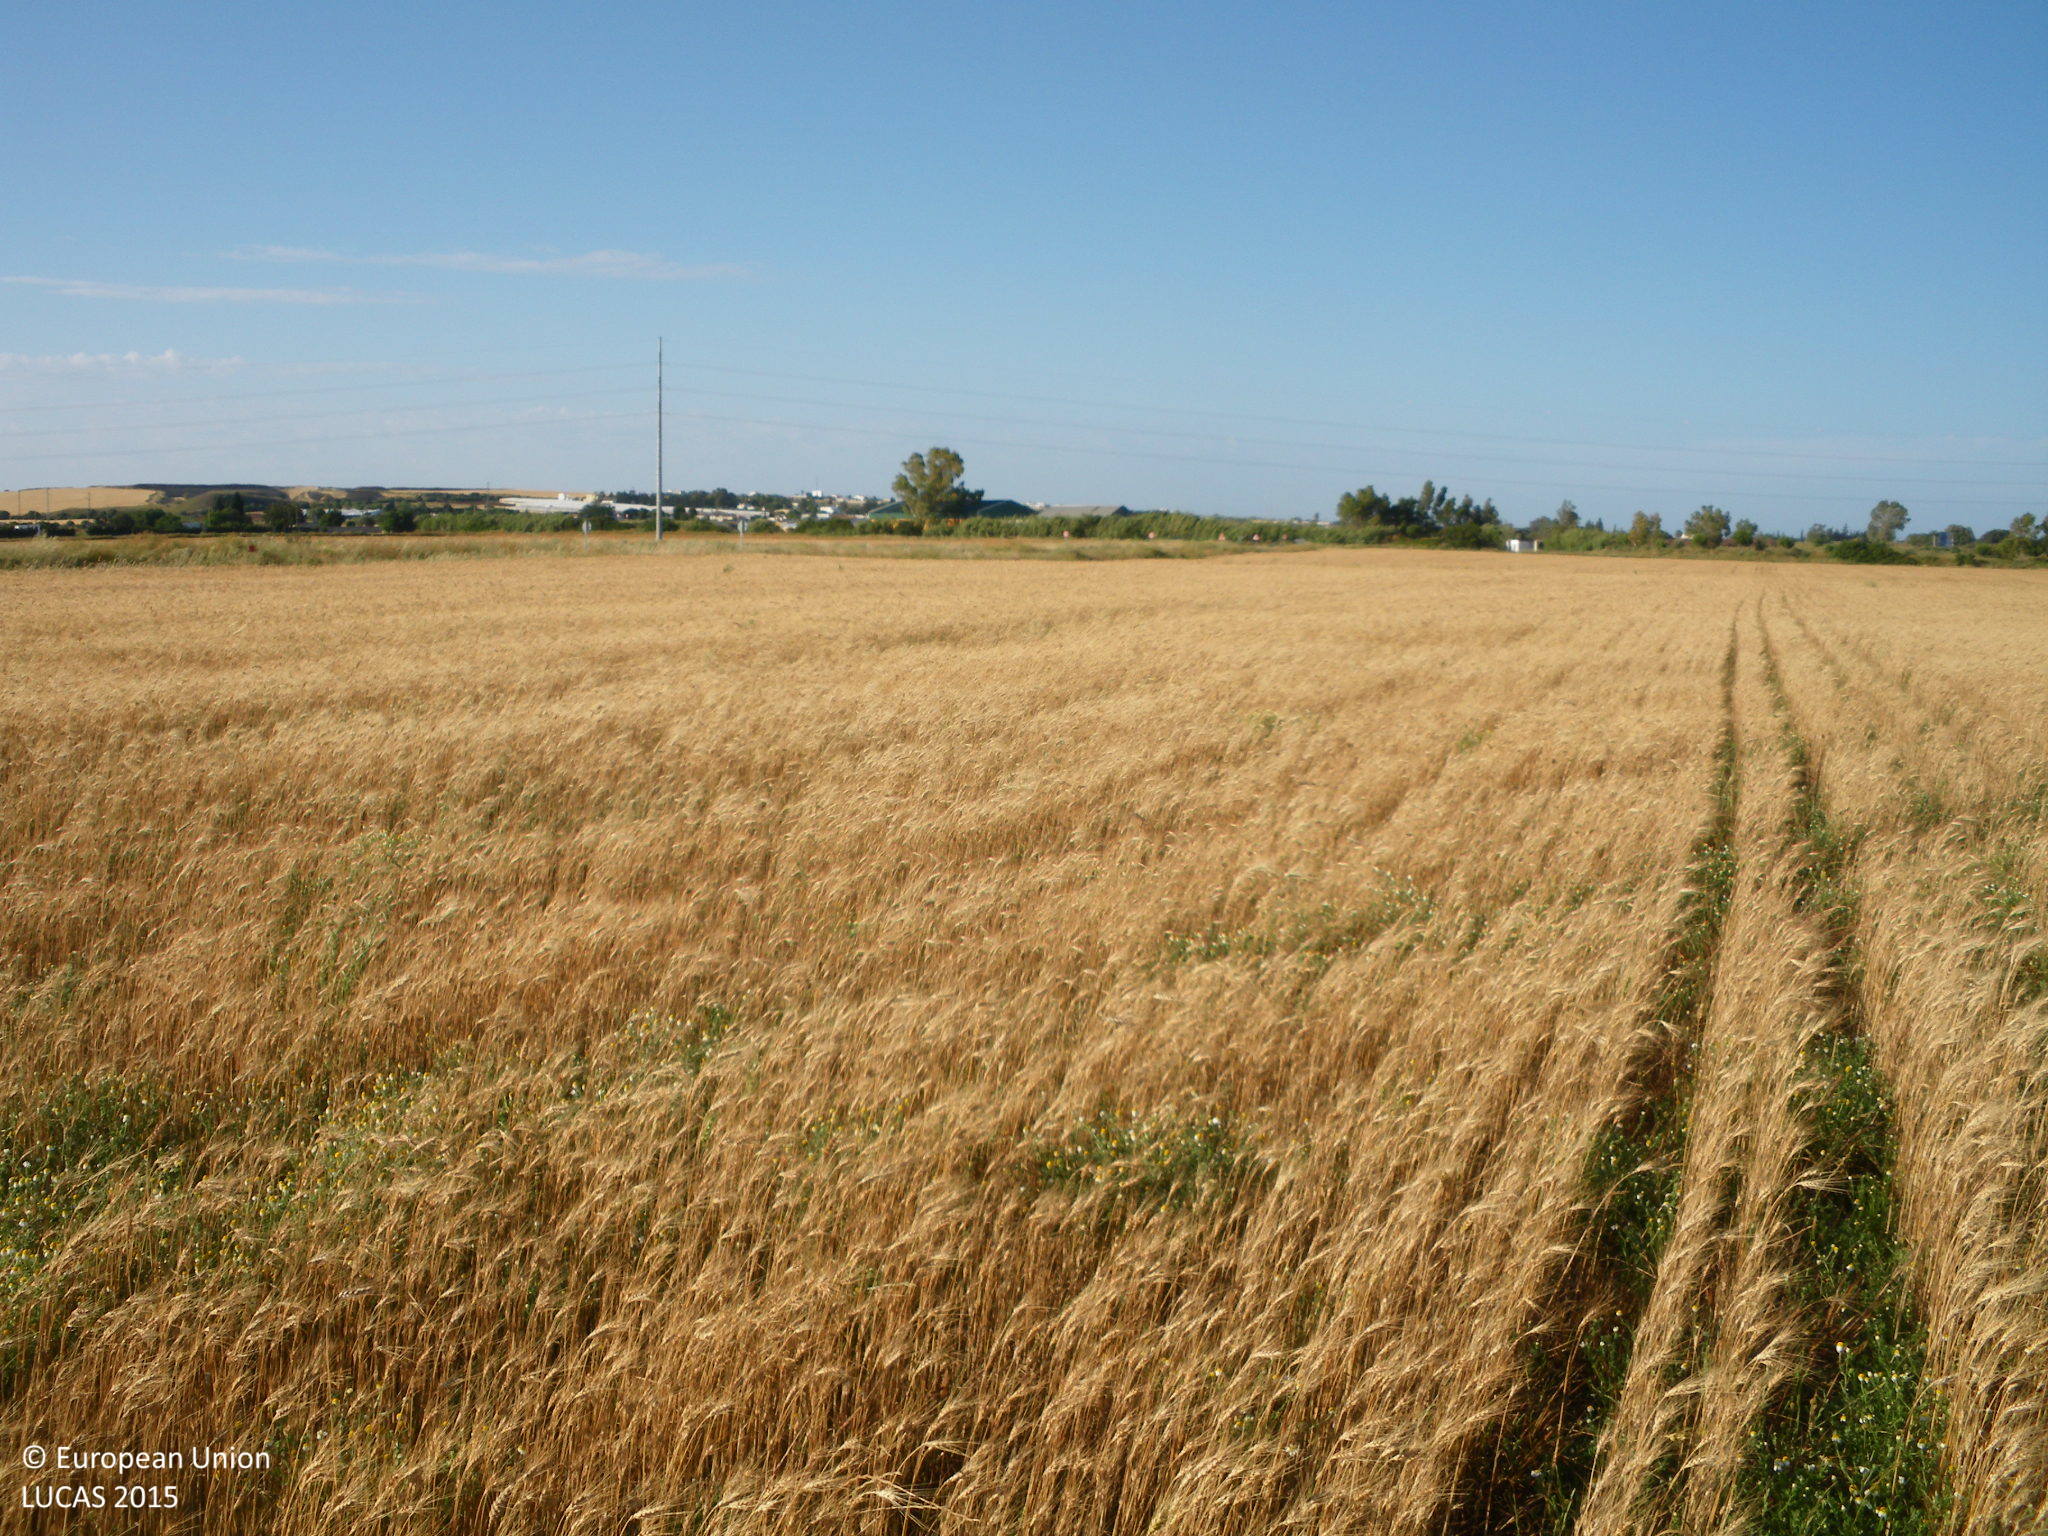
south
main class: Cropland
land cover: Durum wheat
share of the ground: > 75 %
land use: Agriculture (excluding fallow land and kitchen gardens)
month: May
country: ES
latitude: 36.3541
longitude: -6.0621
